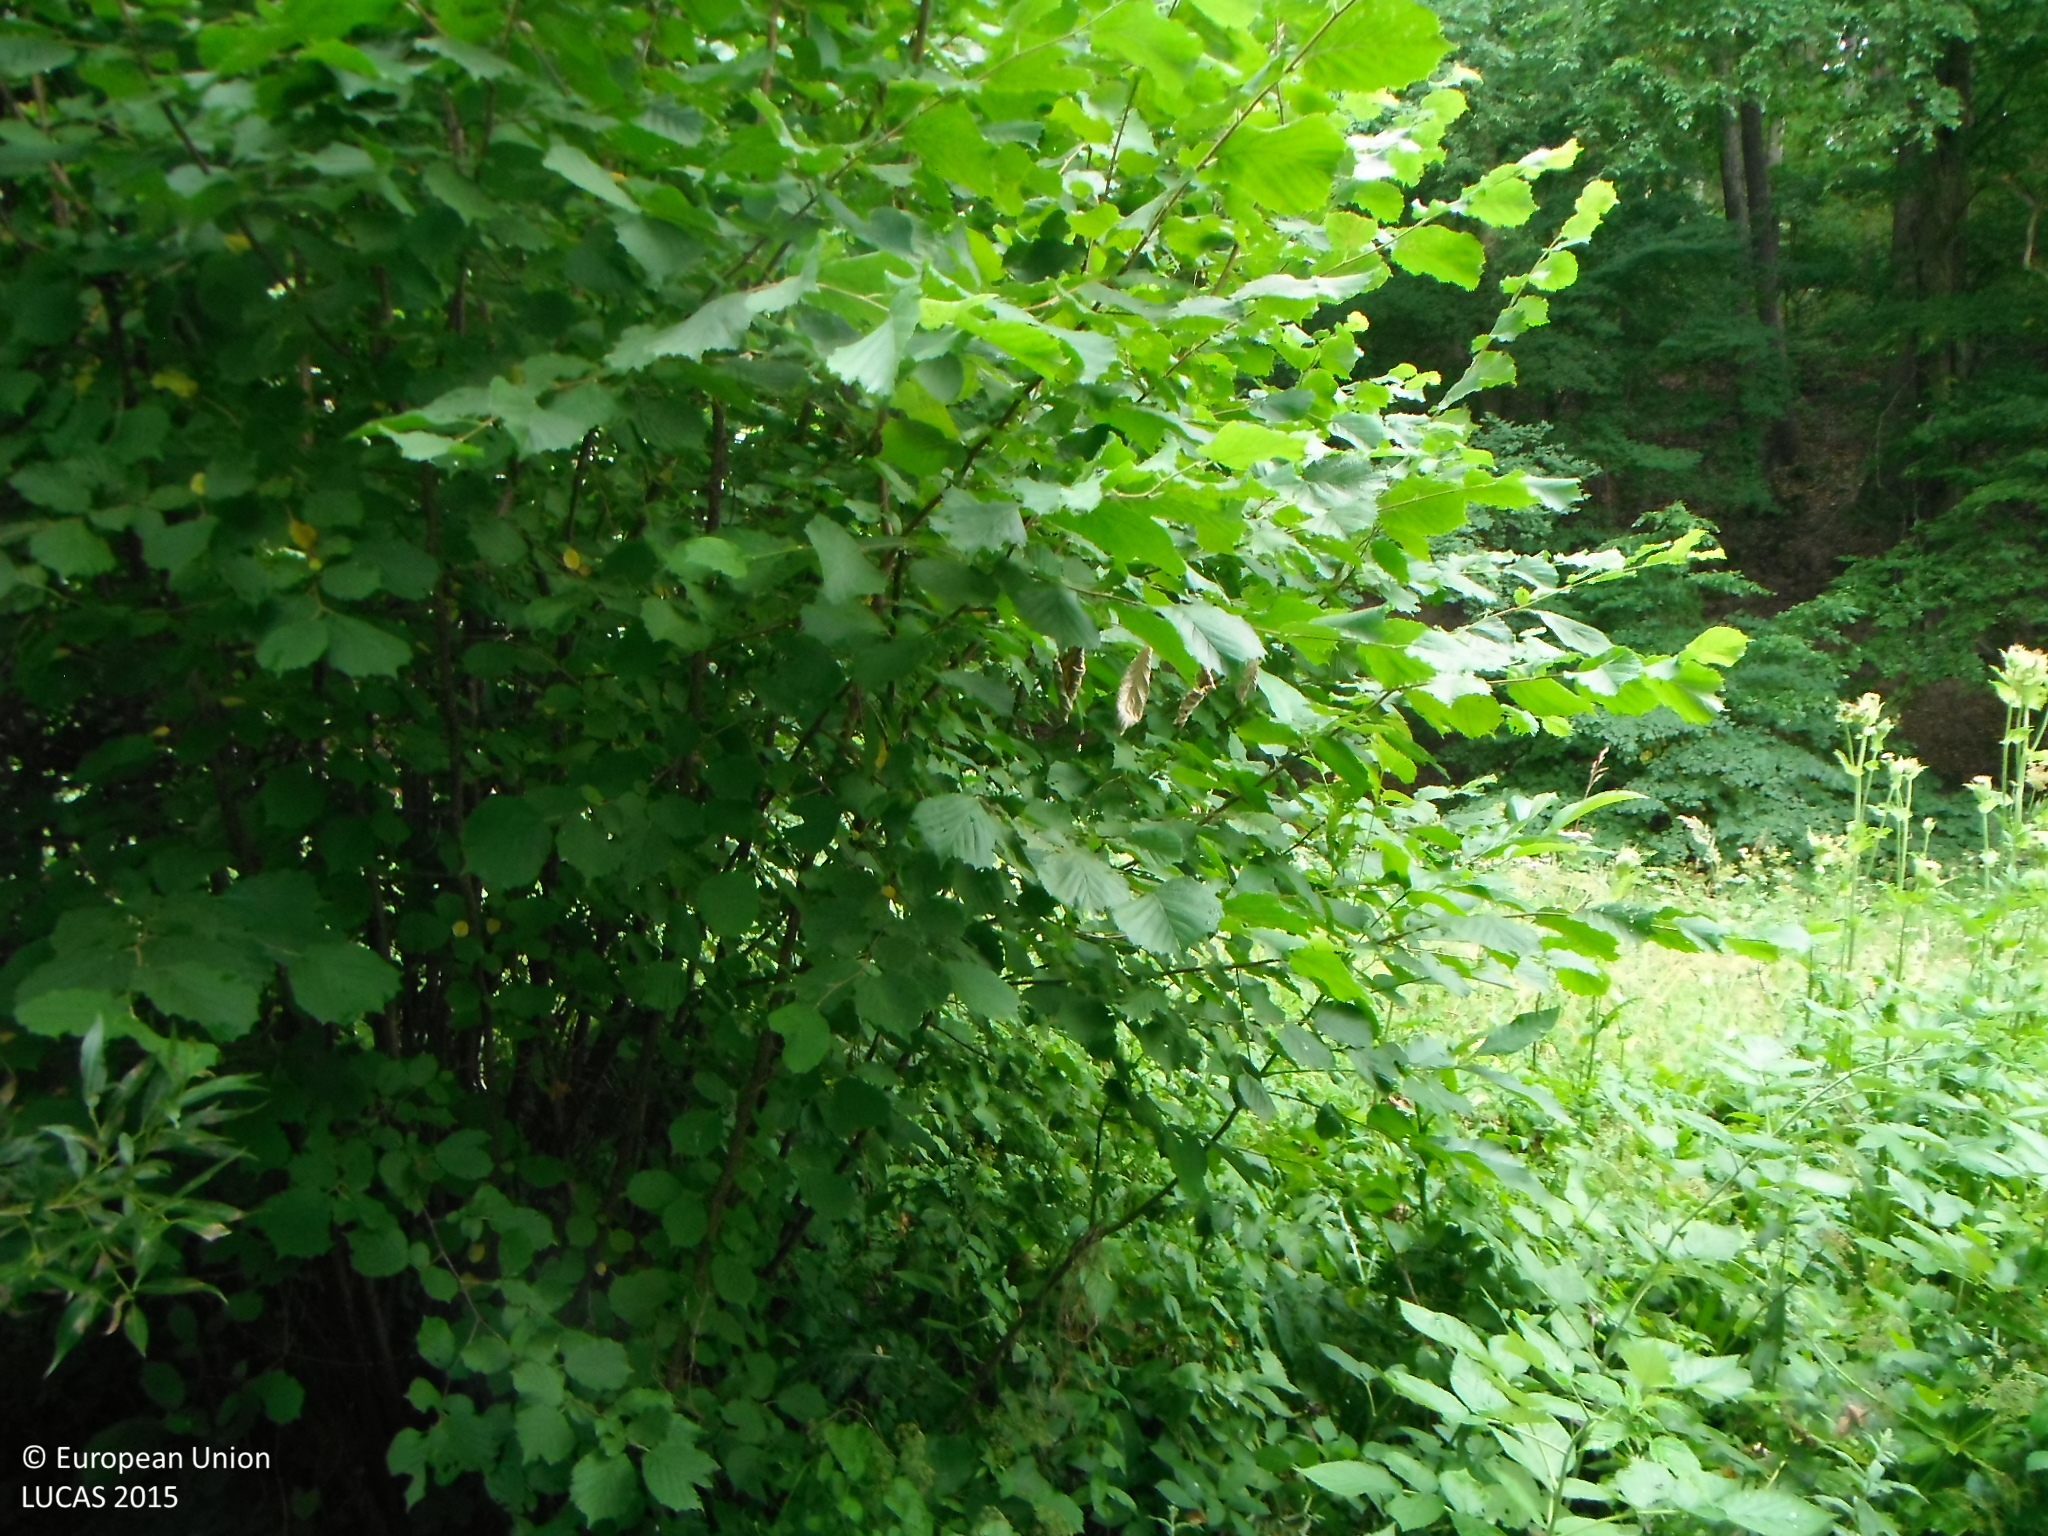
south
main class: Woodland
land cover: Broadleaved woodland
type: floodplain forest
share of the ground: > 75 %
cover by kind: broadleaved forest trees 80 %, shrubs 20 %
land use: Forestry
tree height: > 5 m
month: July
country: SK
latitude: 48.3755
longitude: 19.0526
